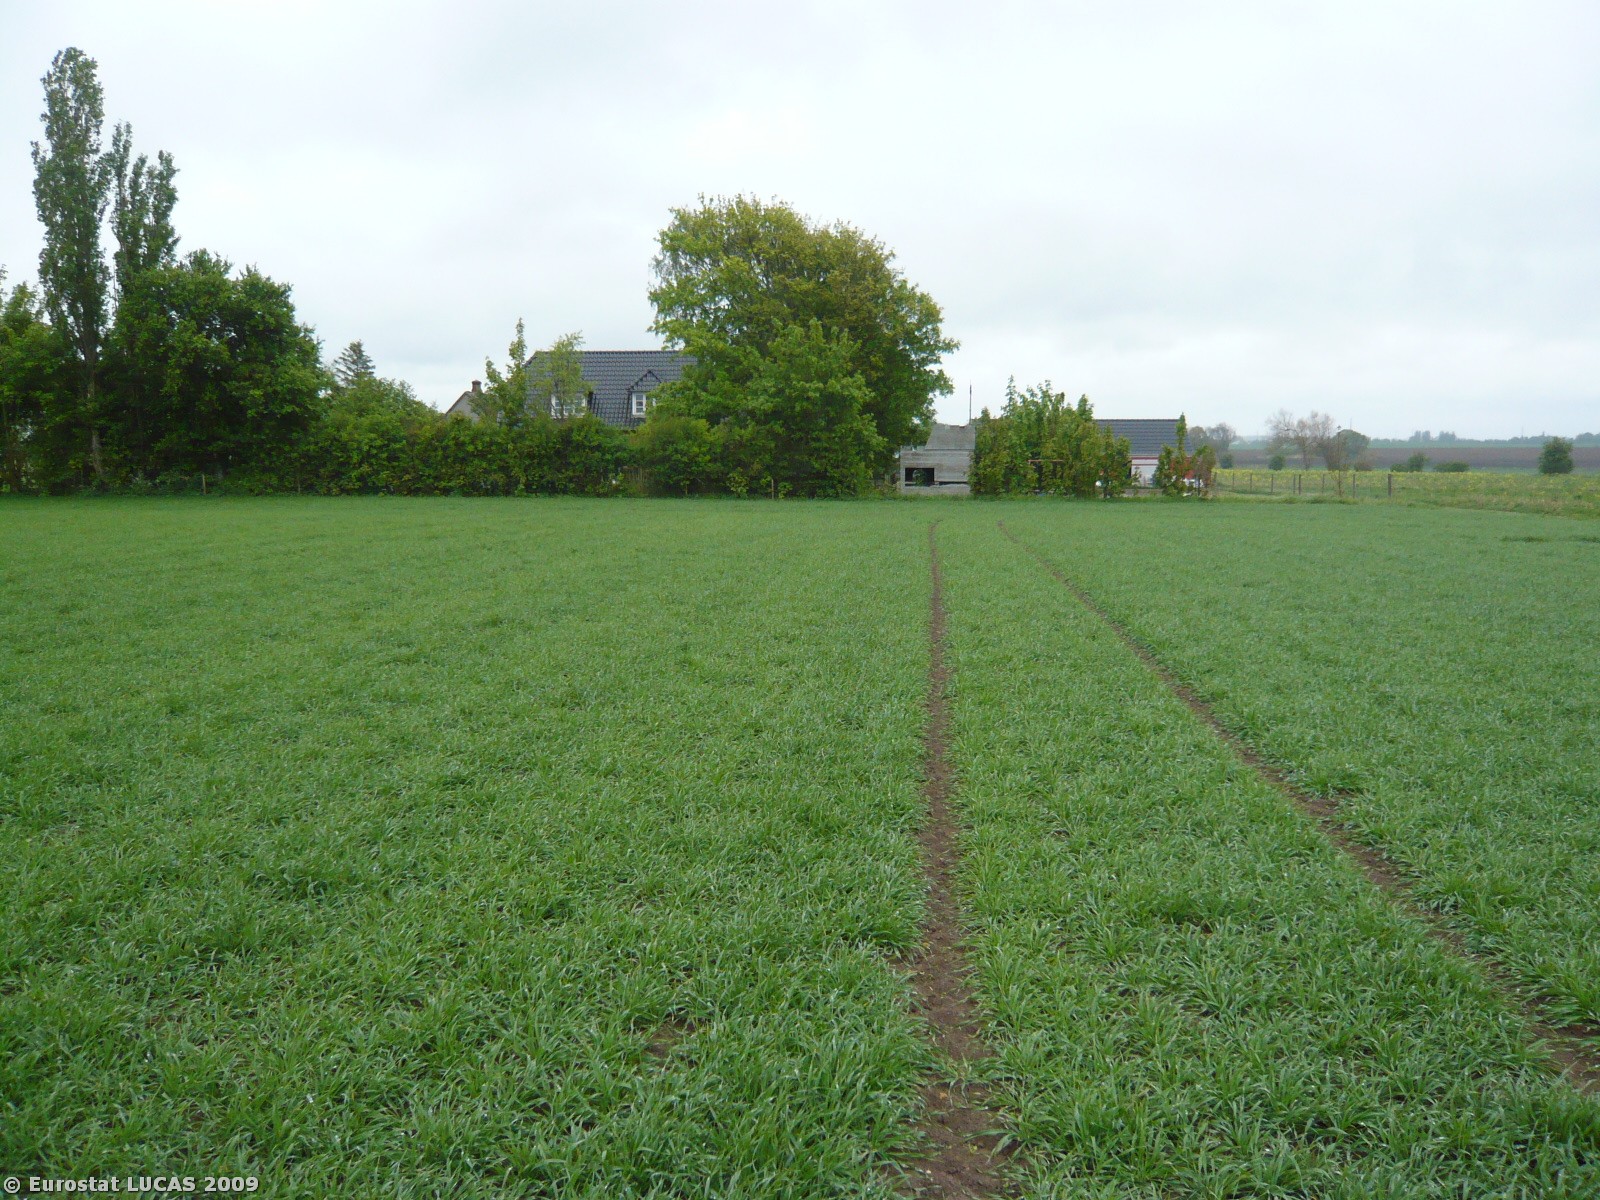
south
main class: Cropland
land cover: Barley
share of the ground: > 75 %
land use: Agriculture (excluding fallow land and kitchen gardens)
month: May
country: DK
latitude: 55.1319
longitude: 11.8338
